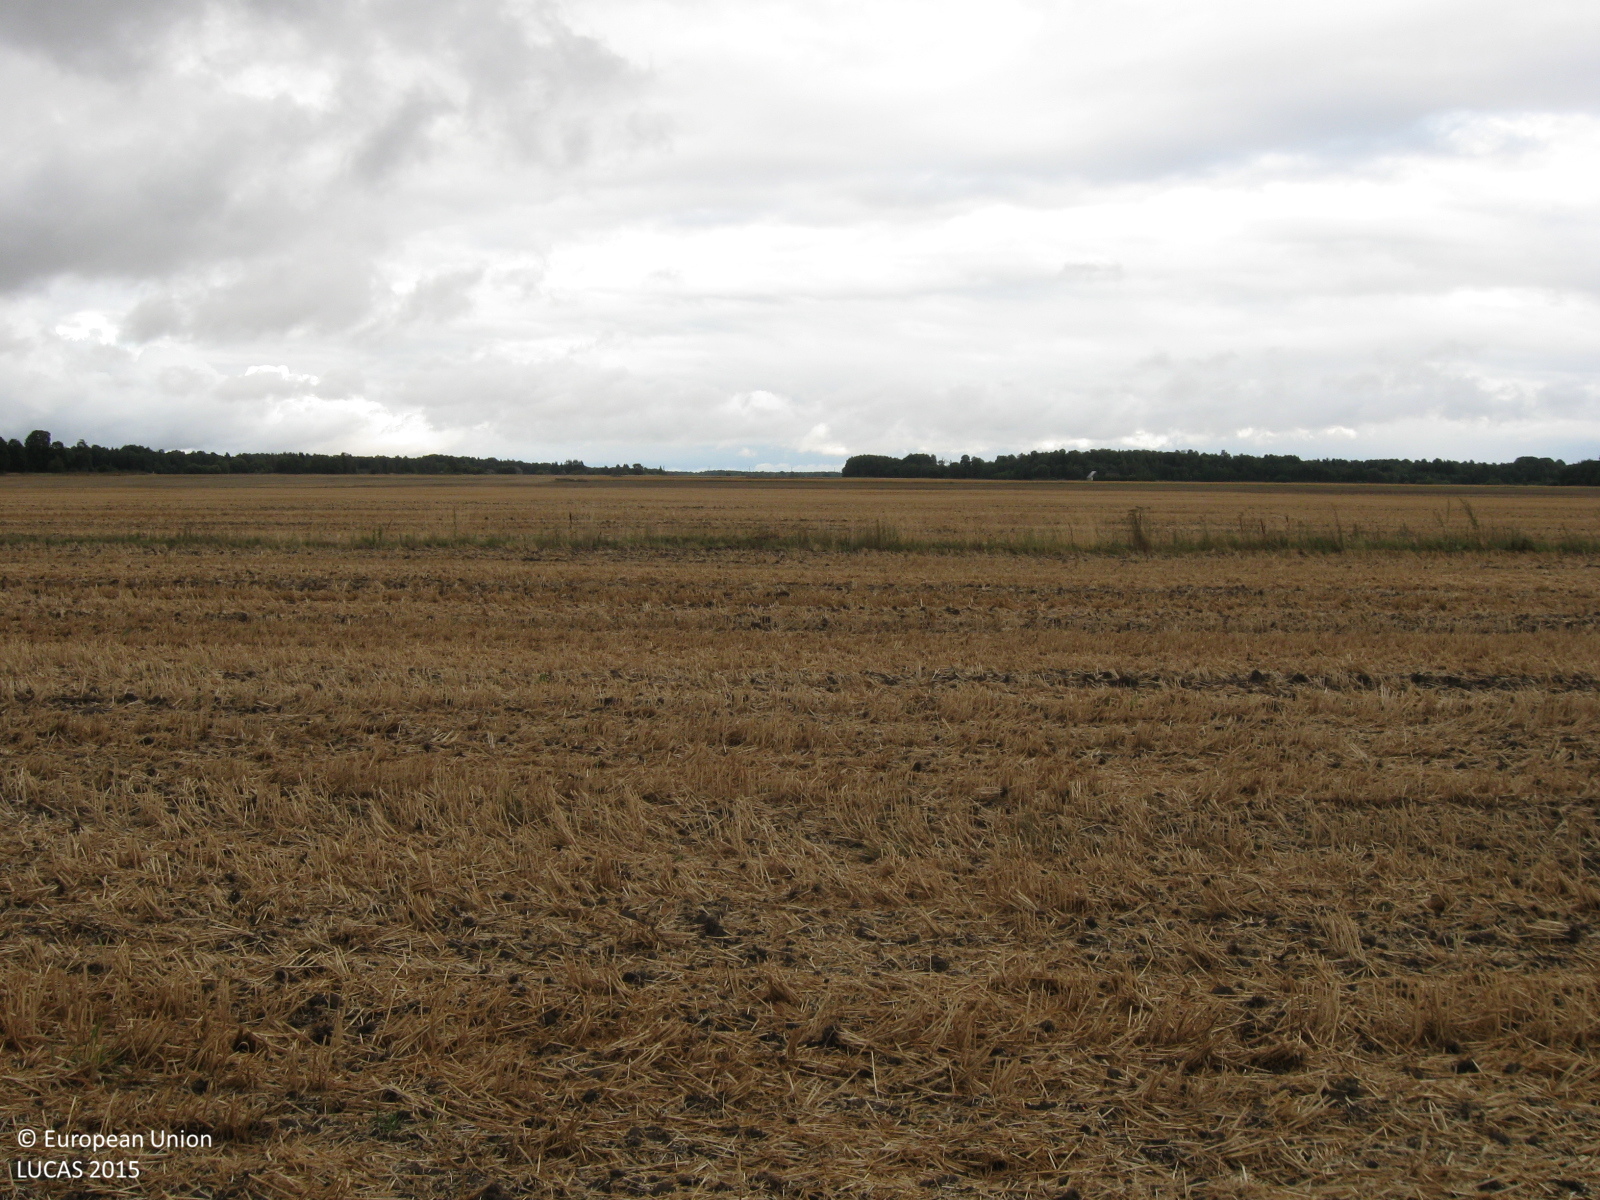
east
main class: Cropland
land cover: Common wheat
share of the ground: 10 - 25 %
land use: Agriculture (excluding fallow land and kitchen gardens)
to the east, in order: Common wheat; Grass margins; Tracks; Common wheat
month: August
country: LT
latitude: 55.2423
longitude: 23.2392
